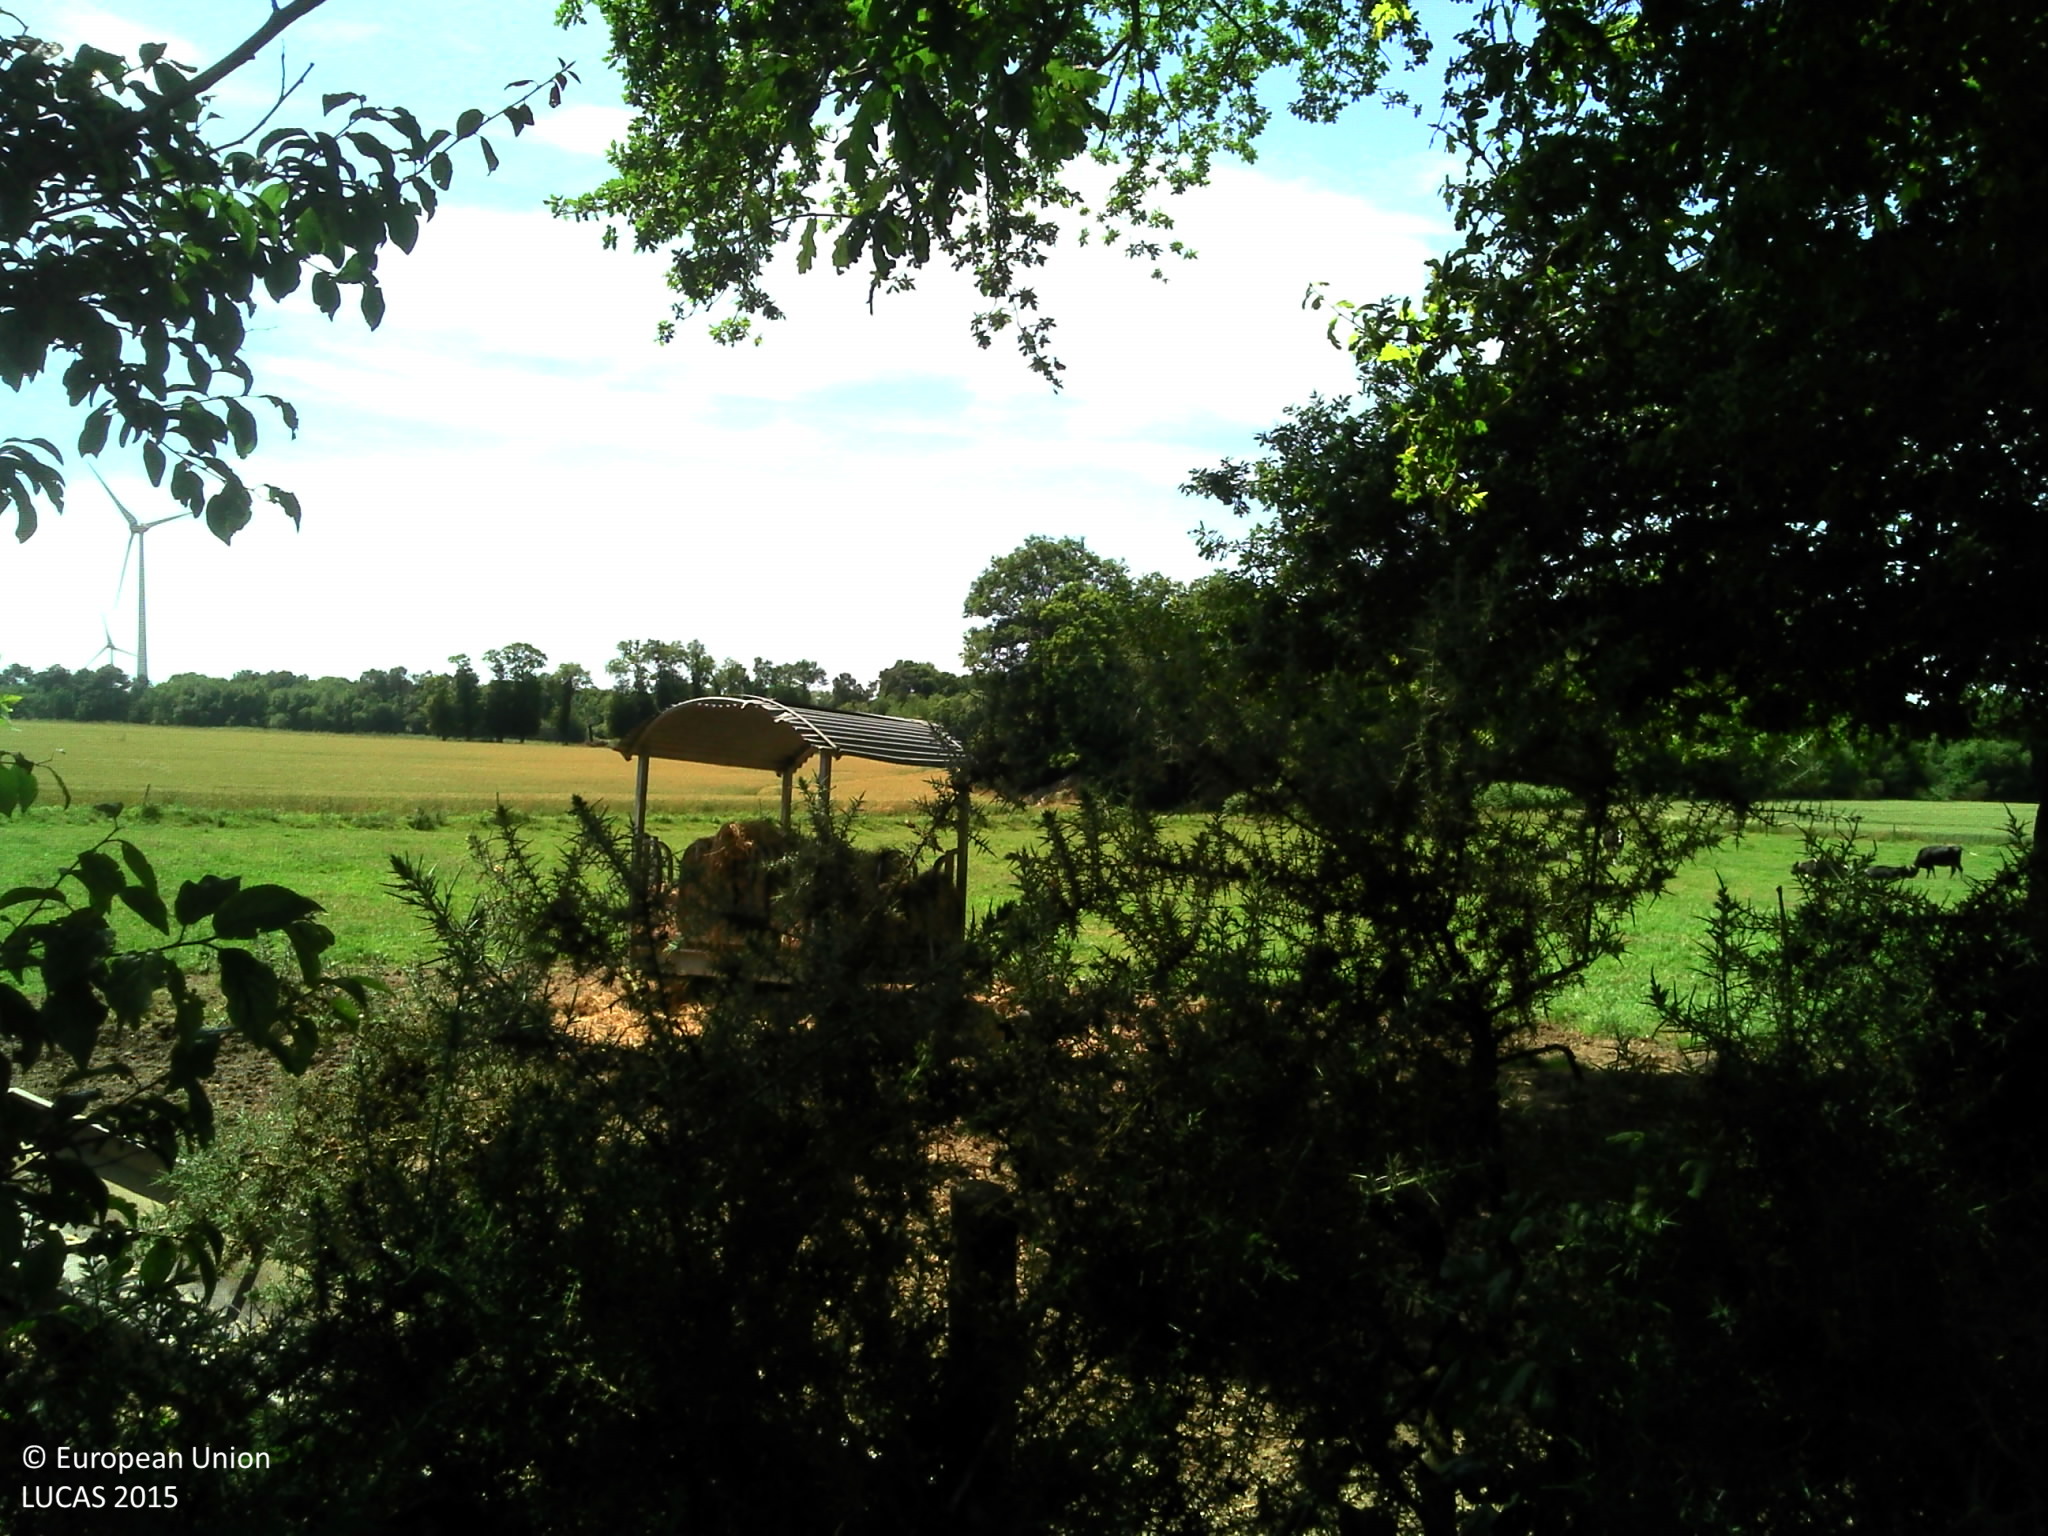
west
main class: Cropland
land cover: Maize
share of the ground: 25 - 50 %
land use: Agriculture (excluding fallow land and kitchen gardens)
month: June
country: FR
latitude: 48.0321
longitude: -2.0557
